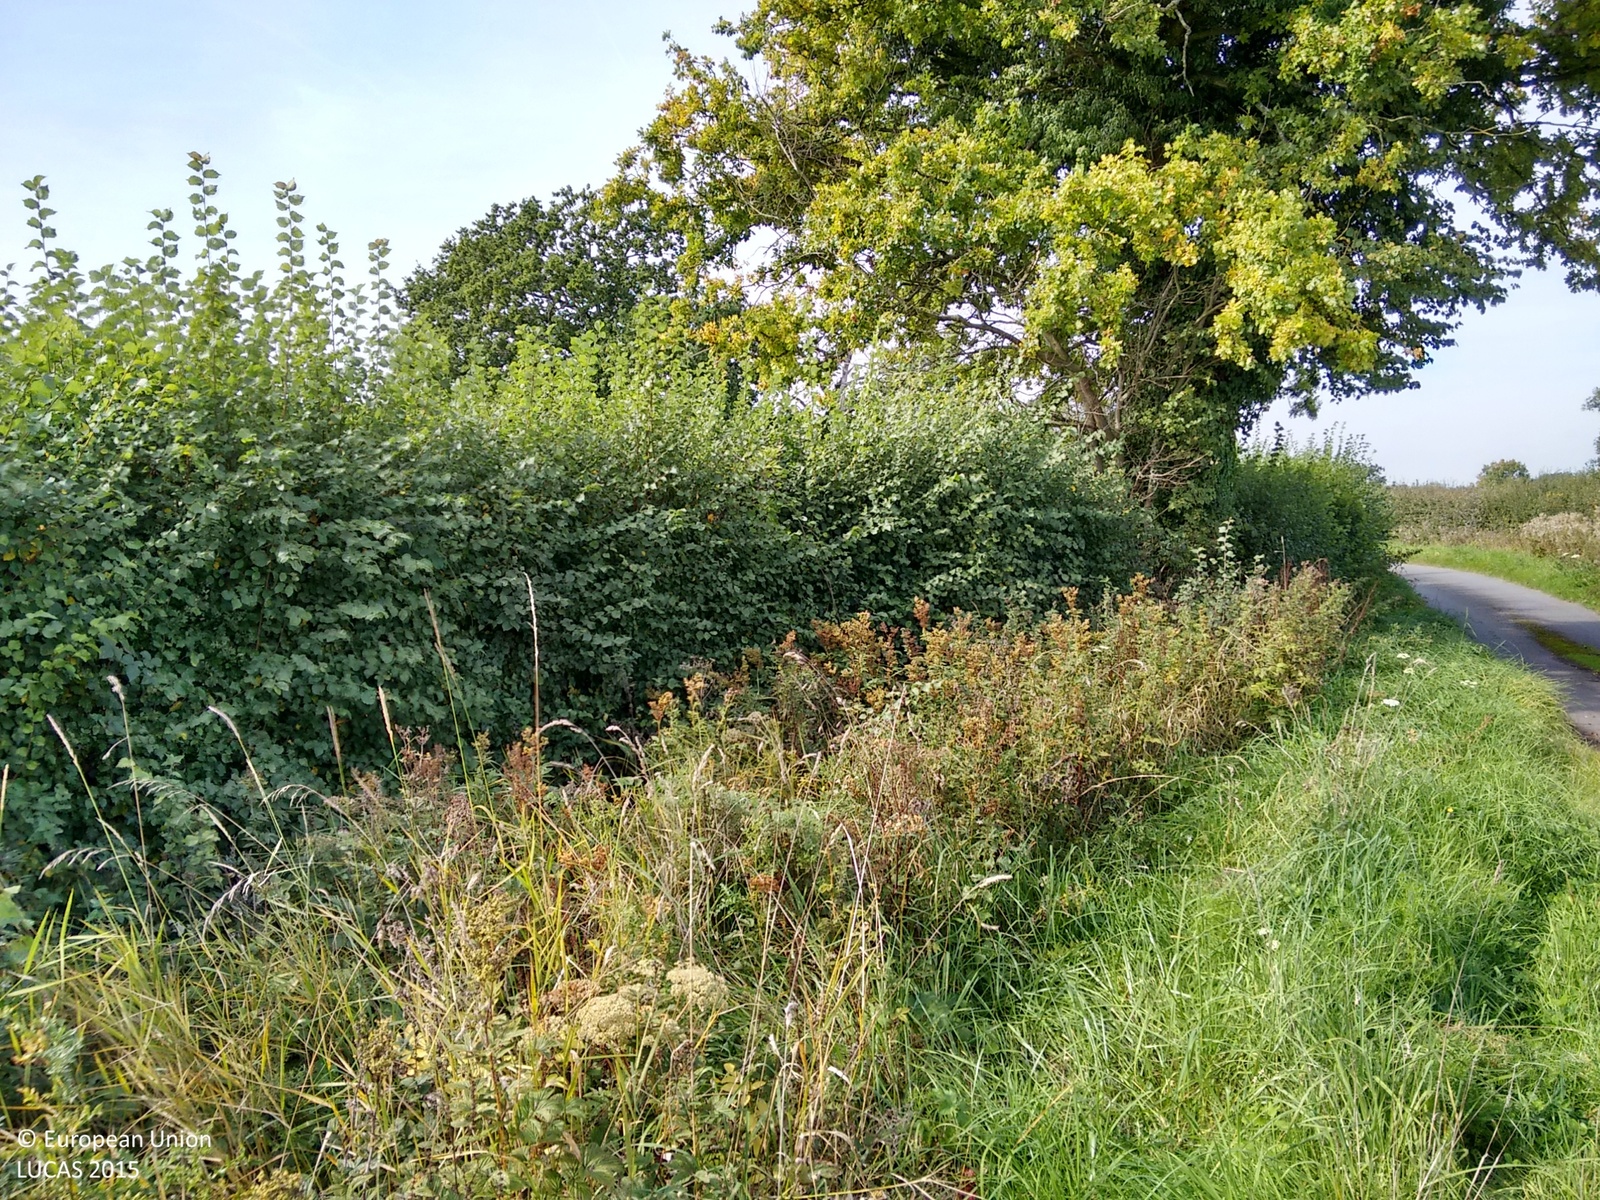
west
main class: Grassland
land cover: Grassland without tree/shrub cover
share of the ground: > 75 %
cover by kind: herbaceous plants 100 %
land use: Road transport
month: September
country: GB
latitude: 51.6667
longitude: -2.4272
